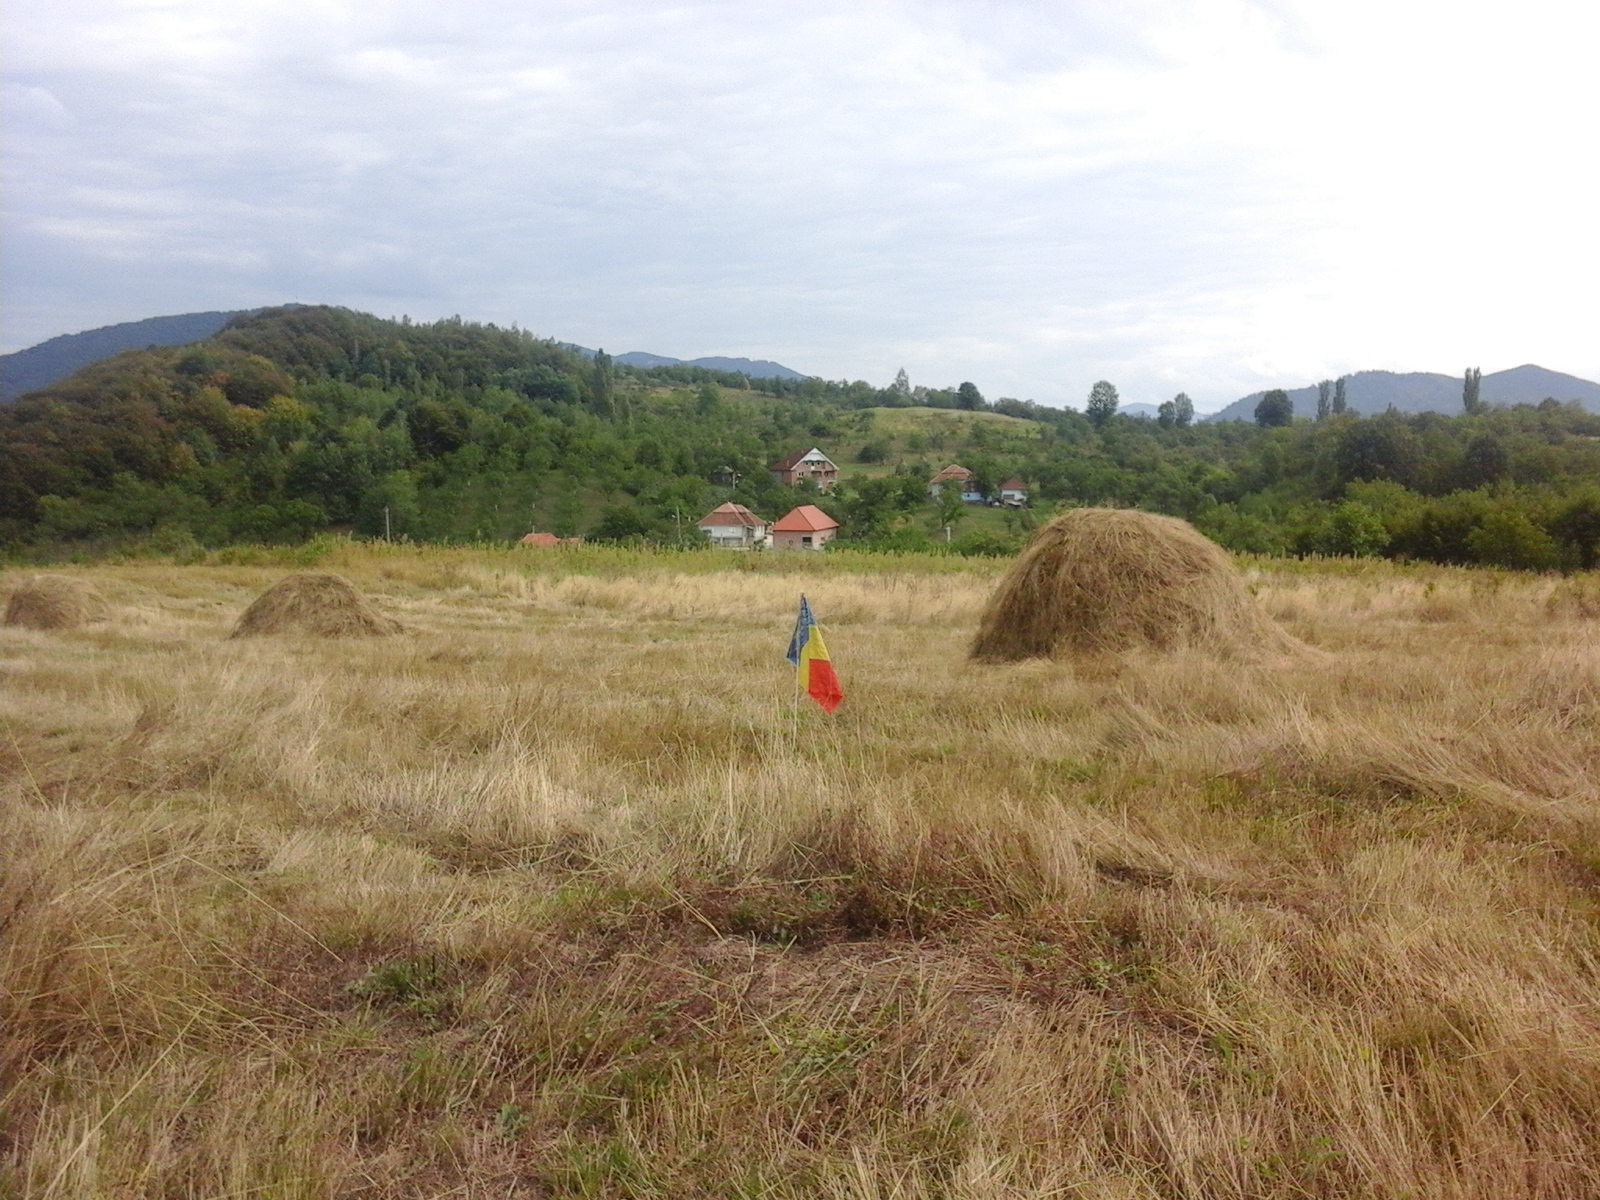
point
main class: Grassland
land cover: Grassland without tree/shrub cover
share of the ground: > 75 %
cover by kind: herbaceous plants 100 %
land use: Agriculture (excluding fallow land and kitchen gardens)
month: September
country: RO
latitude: 47.9791
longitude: 23.2958
